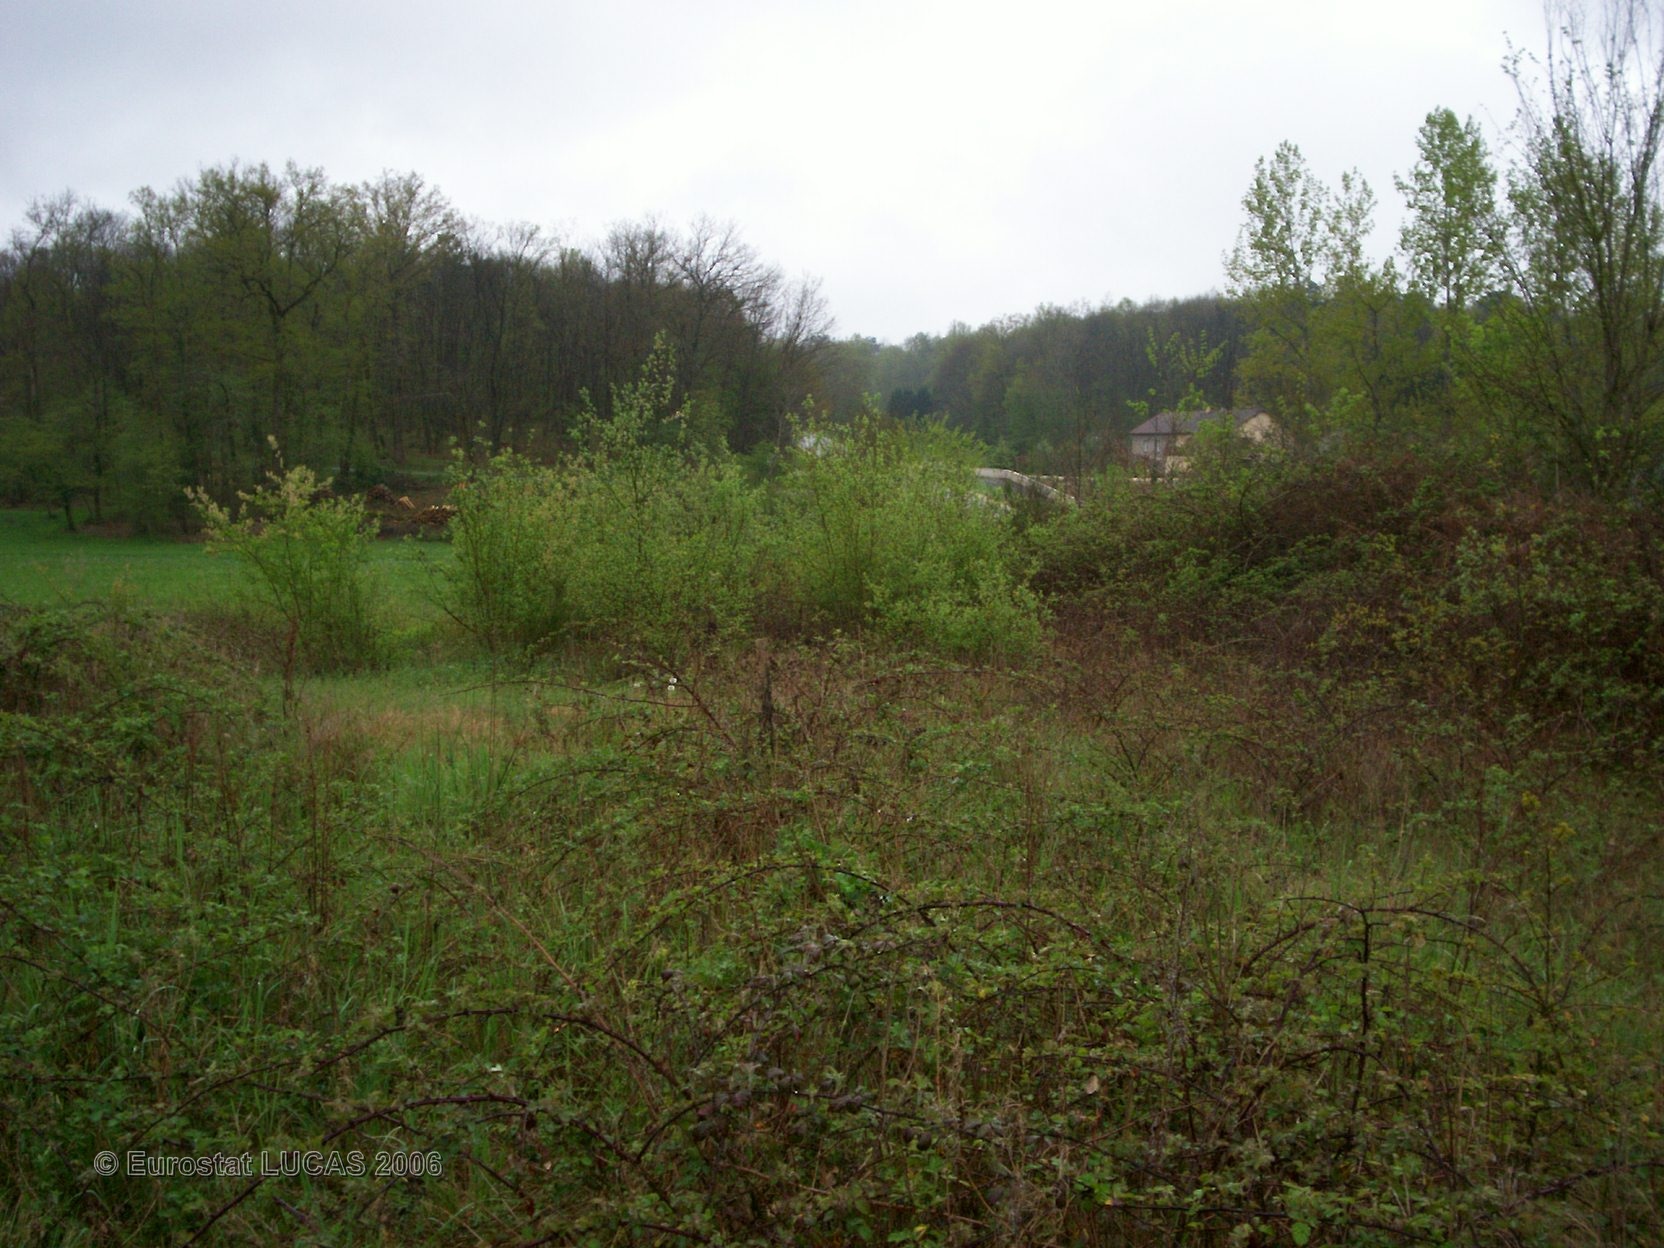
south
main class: Grassland
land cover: Grassland with sparse tree/shrub cover
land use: Unused
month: April
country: FR
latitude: 45.3947
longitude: 0.6252
